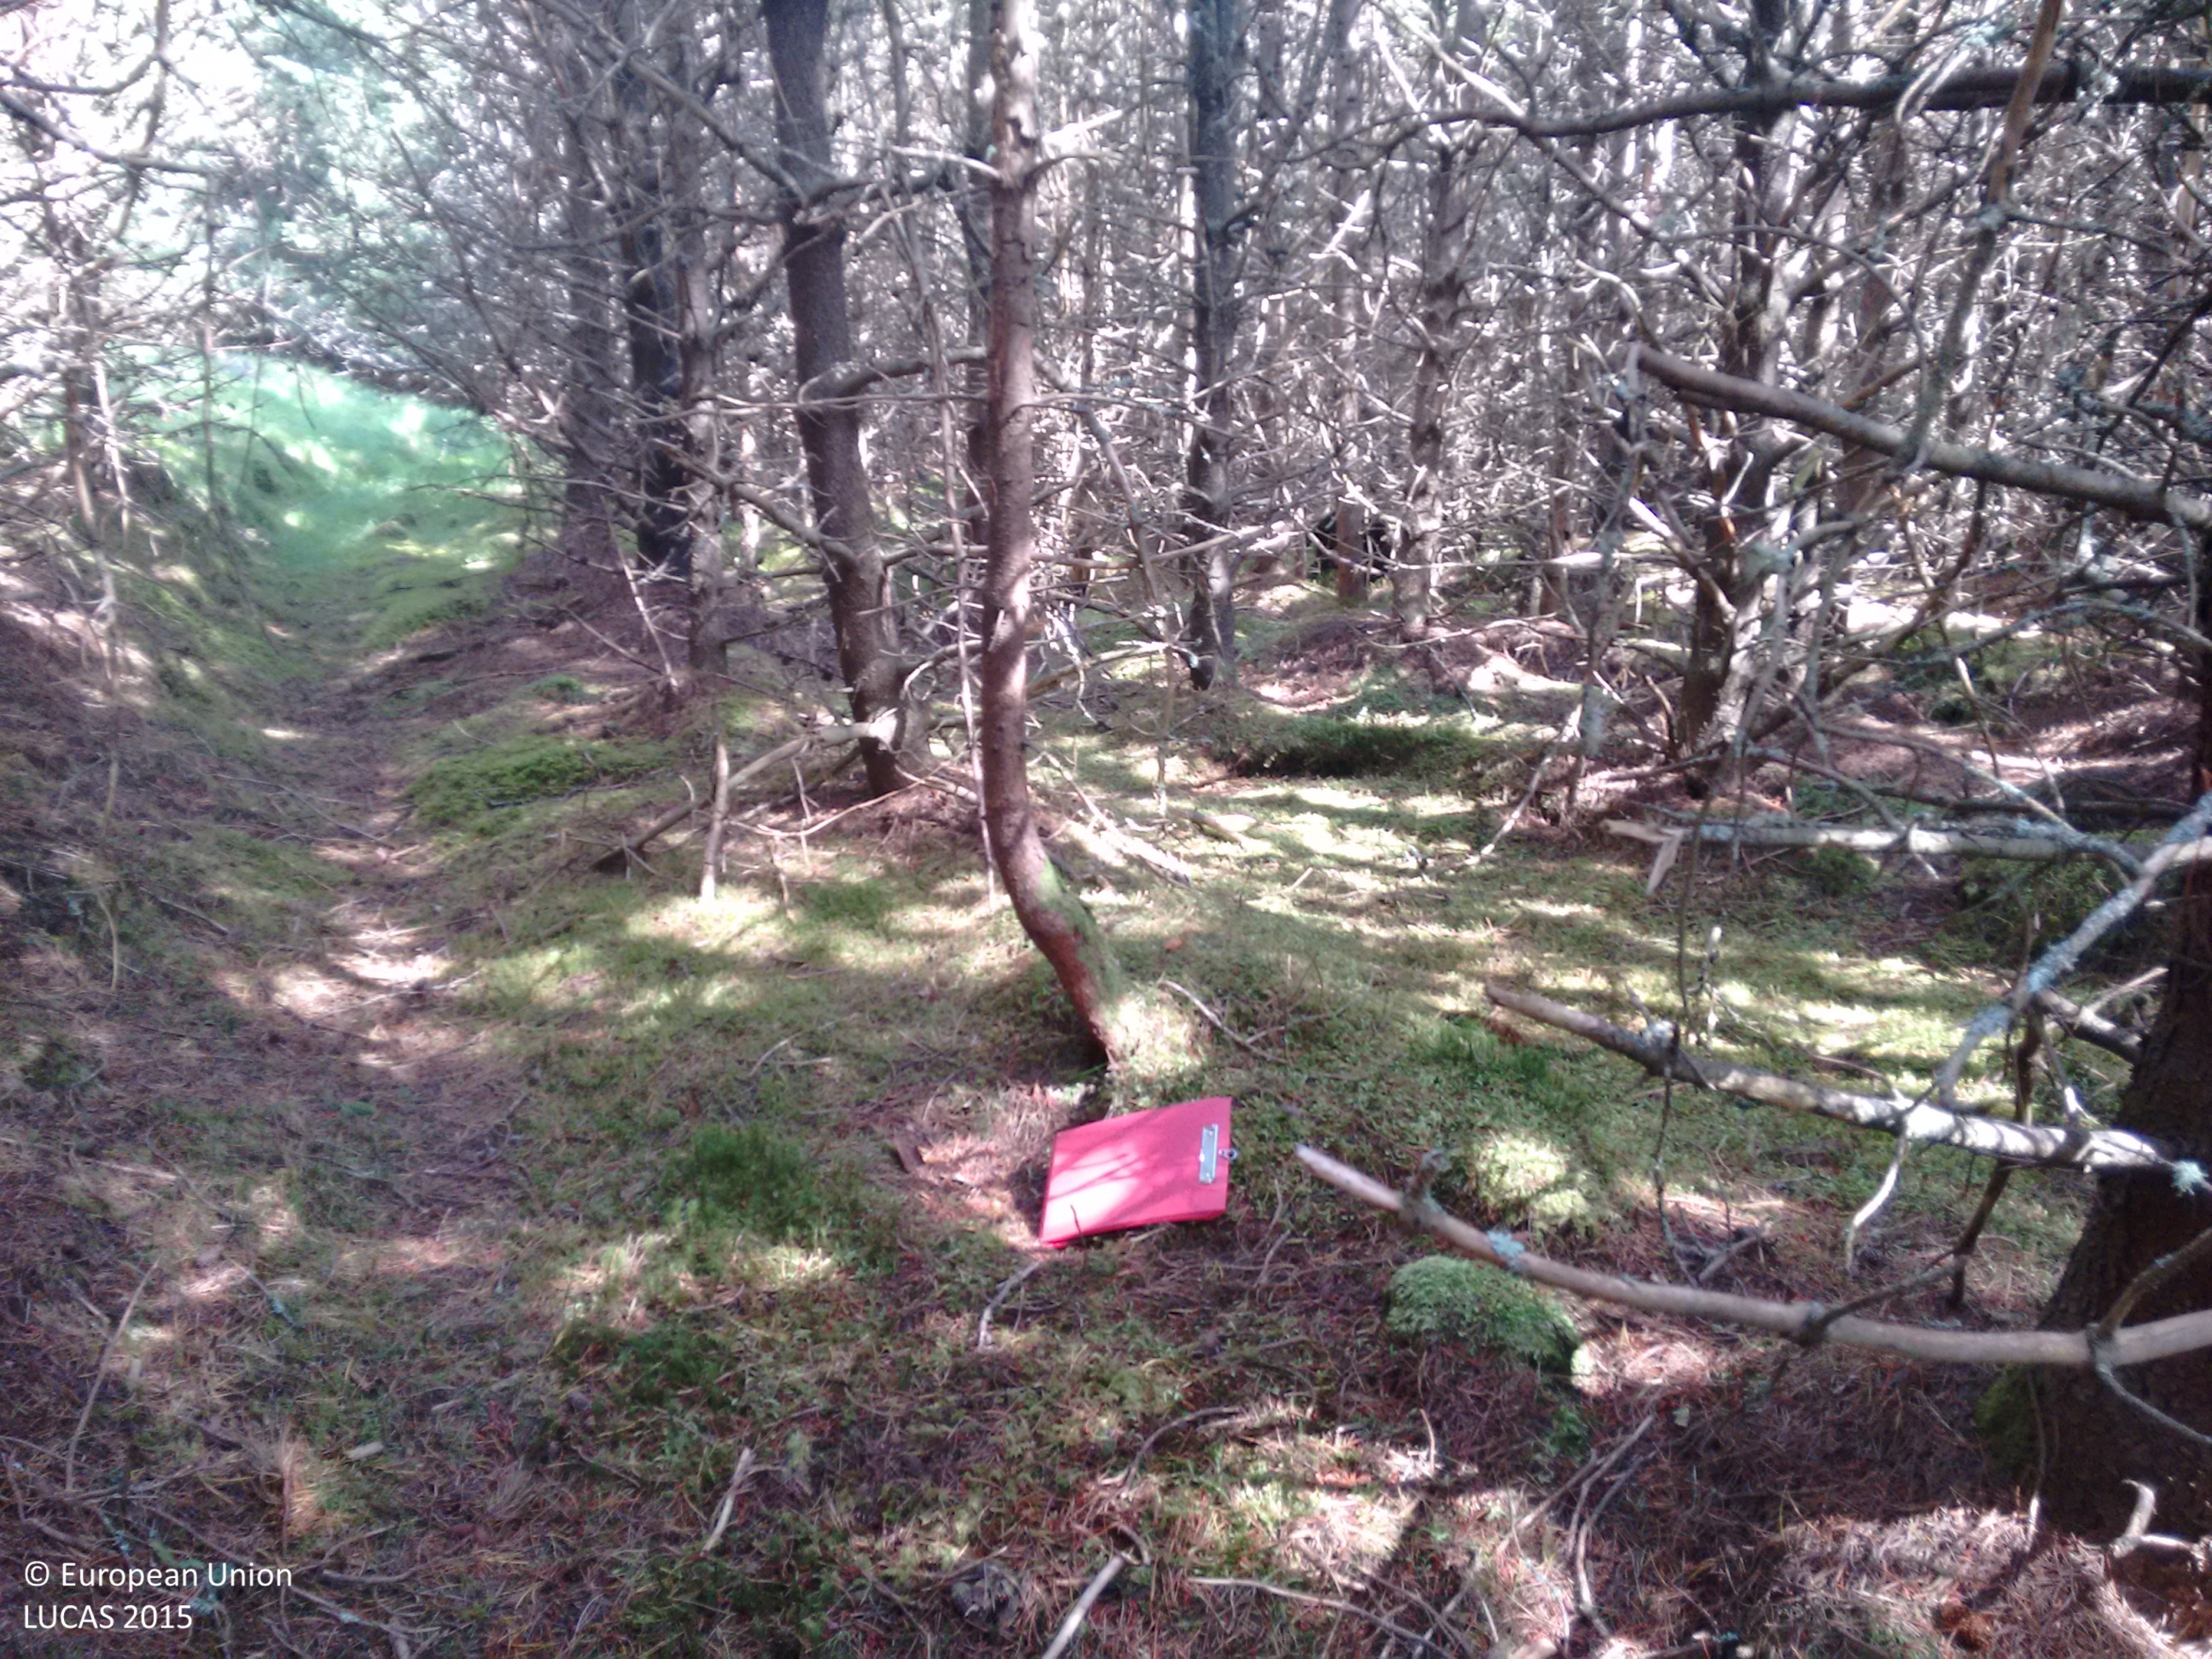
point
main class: Woodland
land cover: Pine dominated coniferous woodland
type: exotic forest
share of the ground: > 75 %
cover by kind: coniferous forest trees 100 %
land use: Forestry
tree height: > 5 m
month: August
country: GB
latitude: 57.3261
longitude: -4.2534
